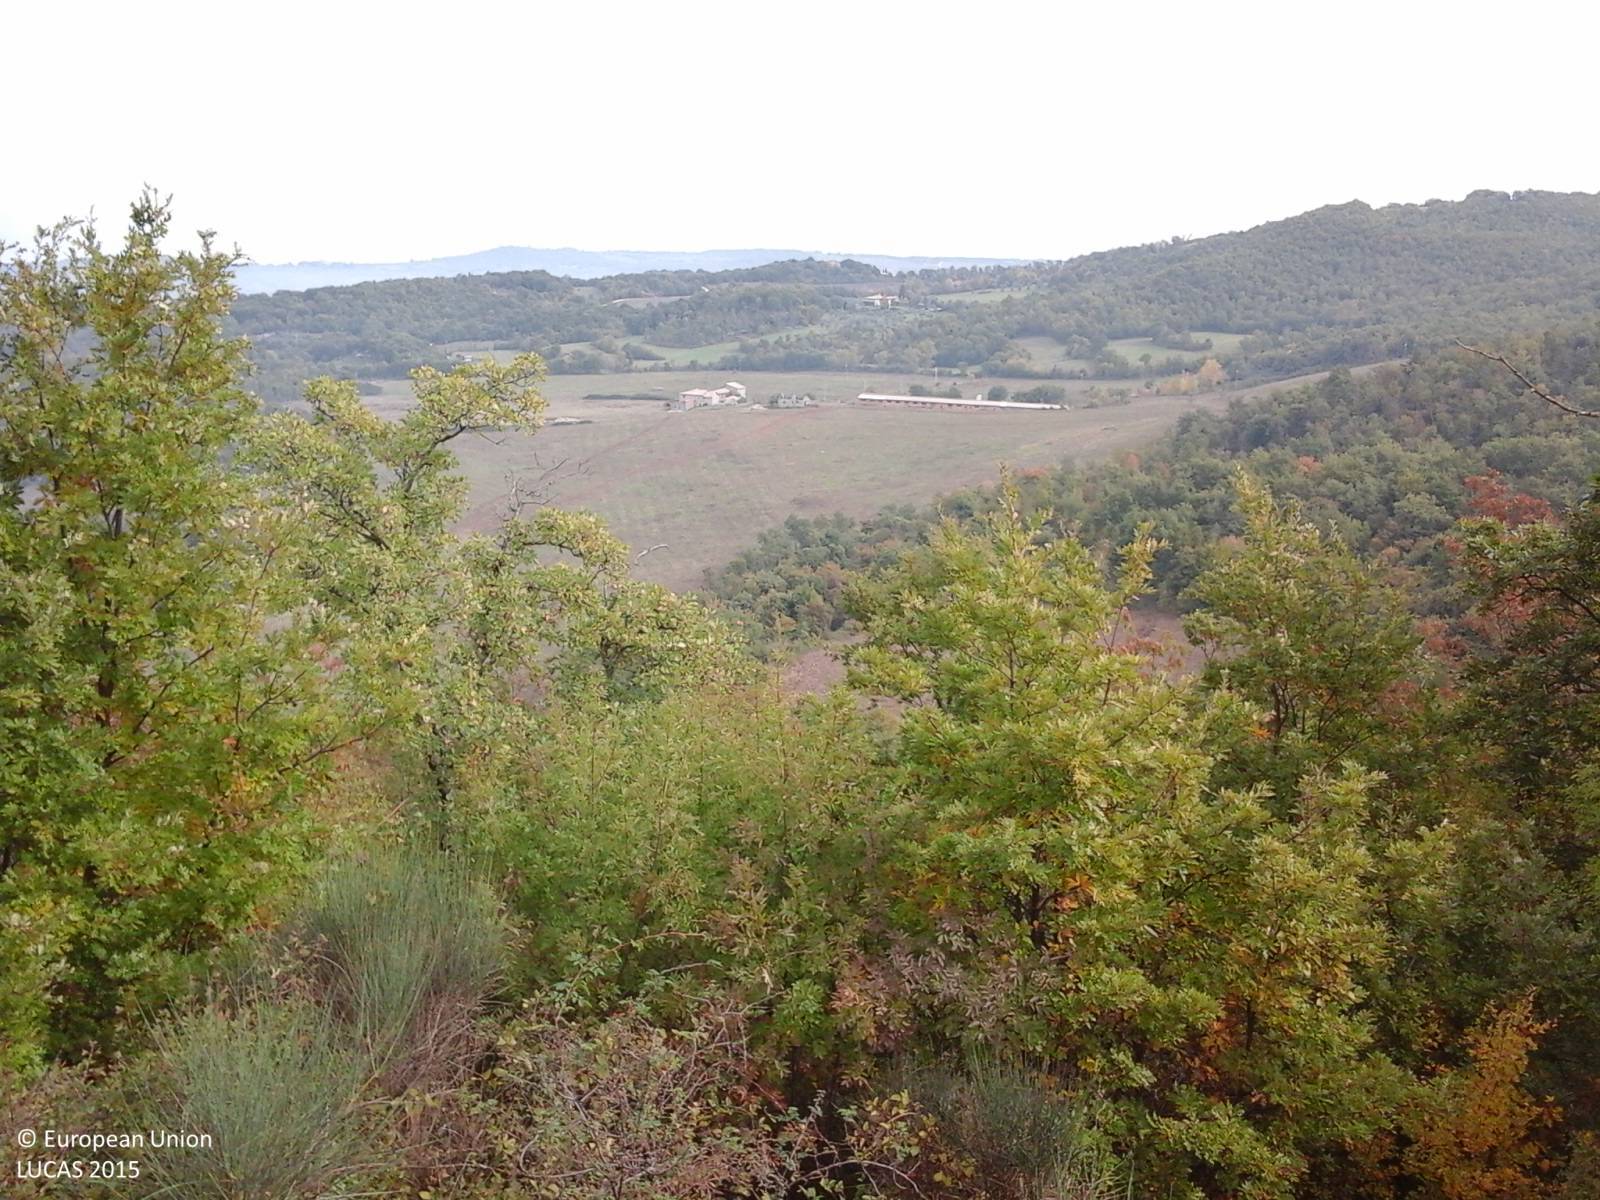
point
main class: Woodland
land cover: Broadleaved woodland
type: thermophilous deciduous forest
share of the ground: > 75 %
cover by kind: broadleaved forest trees 100 %
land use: Forestry
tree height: > 5 m
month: October
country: IT
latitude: 42.7177
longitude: 12.3249
